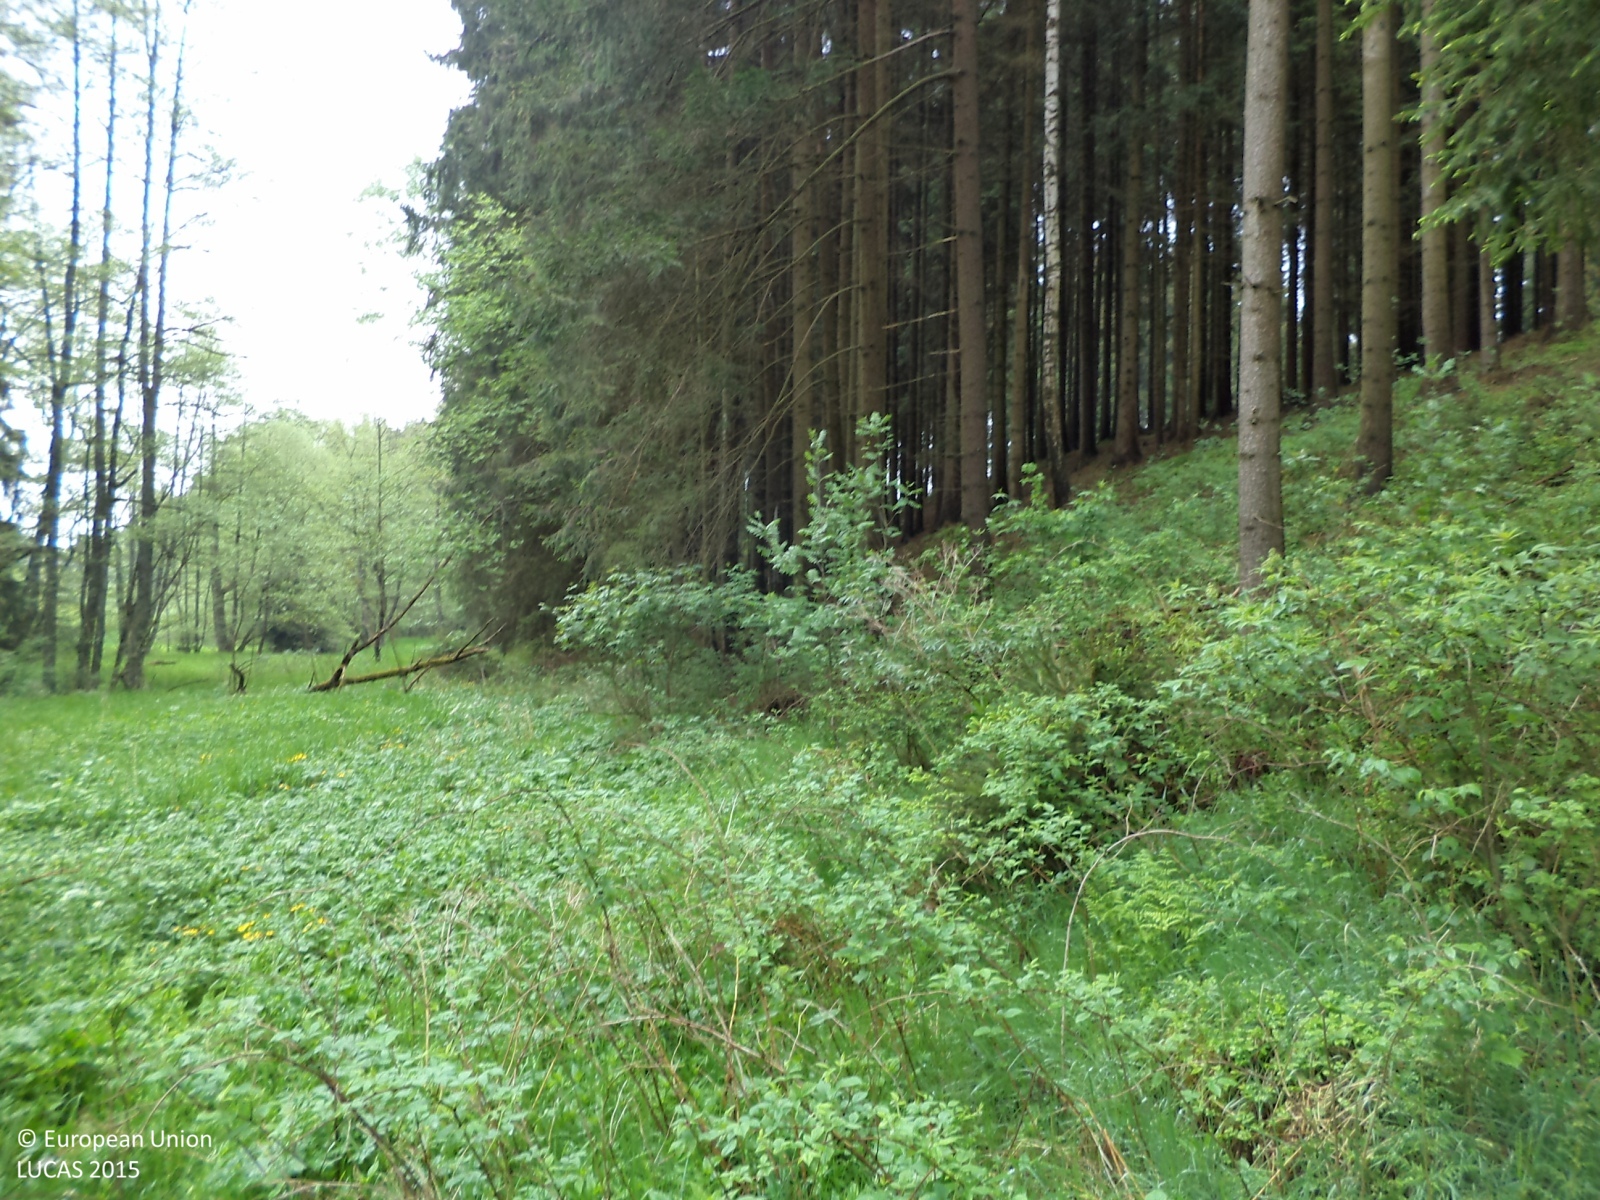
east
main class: Grassland
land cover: Grassland with sparse tree/shrub cover
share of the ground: > 75 %
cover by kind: herbaceous plants 90 %, broadleaved forest trees 5 %, shrubs 5 %
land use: Forestry
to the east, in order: Grassland with sparse tree/shrub cover; Spruce dominated coniferous woodland; Spontaneously vegetated surfaces; Rivers and streams; Spruce dominated coniferous woodland; Grass margins; Common wheat
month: May
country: CZ
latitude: 49.4831
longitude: 14.9300
